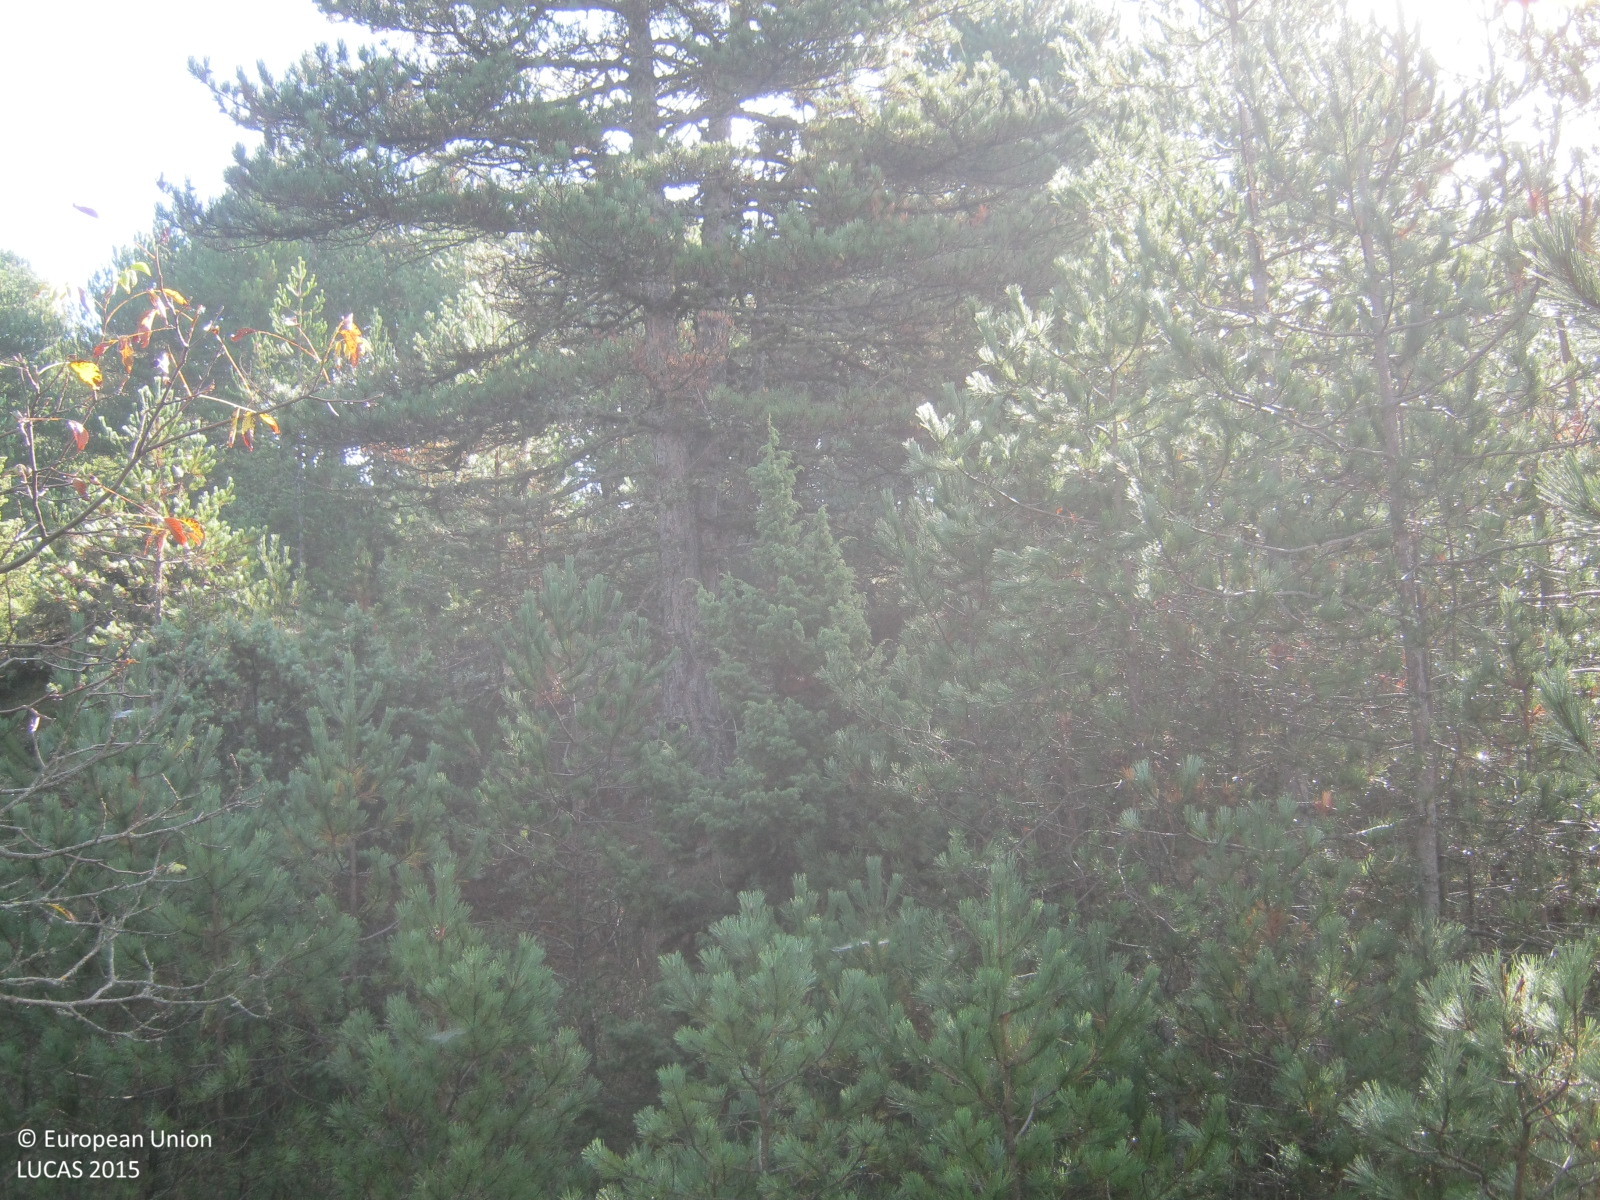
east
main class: Woodland
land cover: Pine dominated mixed woodland
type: coniferous forest of the mediterranean region
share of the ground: > 75 %
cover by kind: coniferous forest trees 60 %, broadleaved forest trees 25 %, herbaceous plants 15 %
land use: Forestry
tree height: > 5 m
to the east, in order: Pine dominated mixed woodland; Rocks and stones; Pine dominated mixed woodland; Grassland with sparse tree/shrub cover; Pine dominated mixed woodland; Grassland with sparse tree/shrub cover; Pine dominated mixed woodland
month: October
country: GR
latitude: 38.0112
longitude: 22.4180
